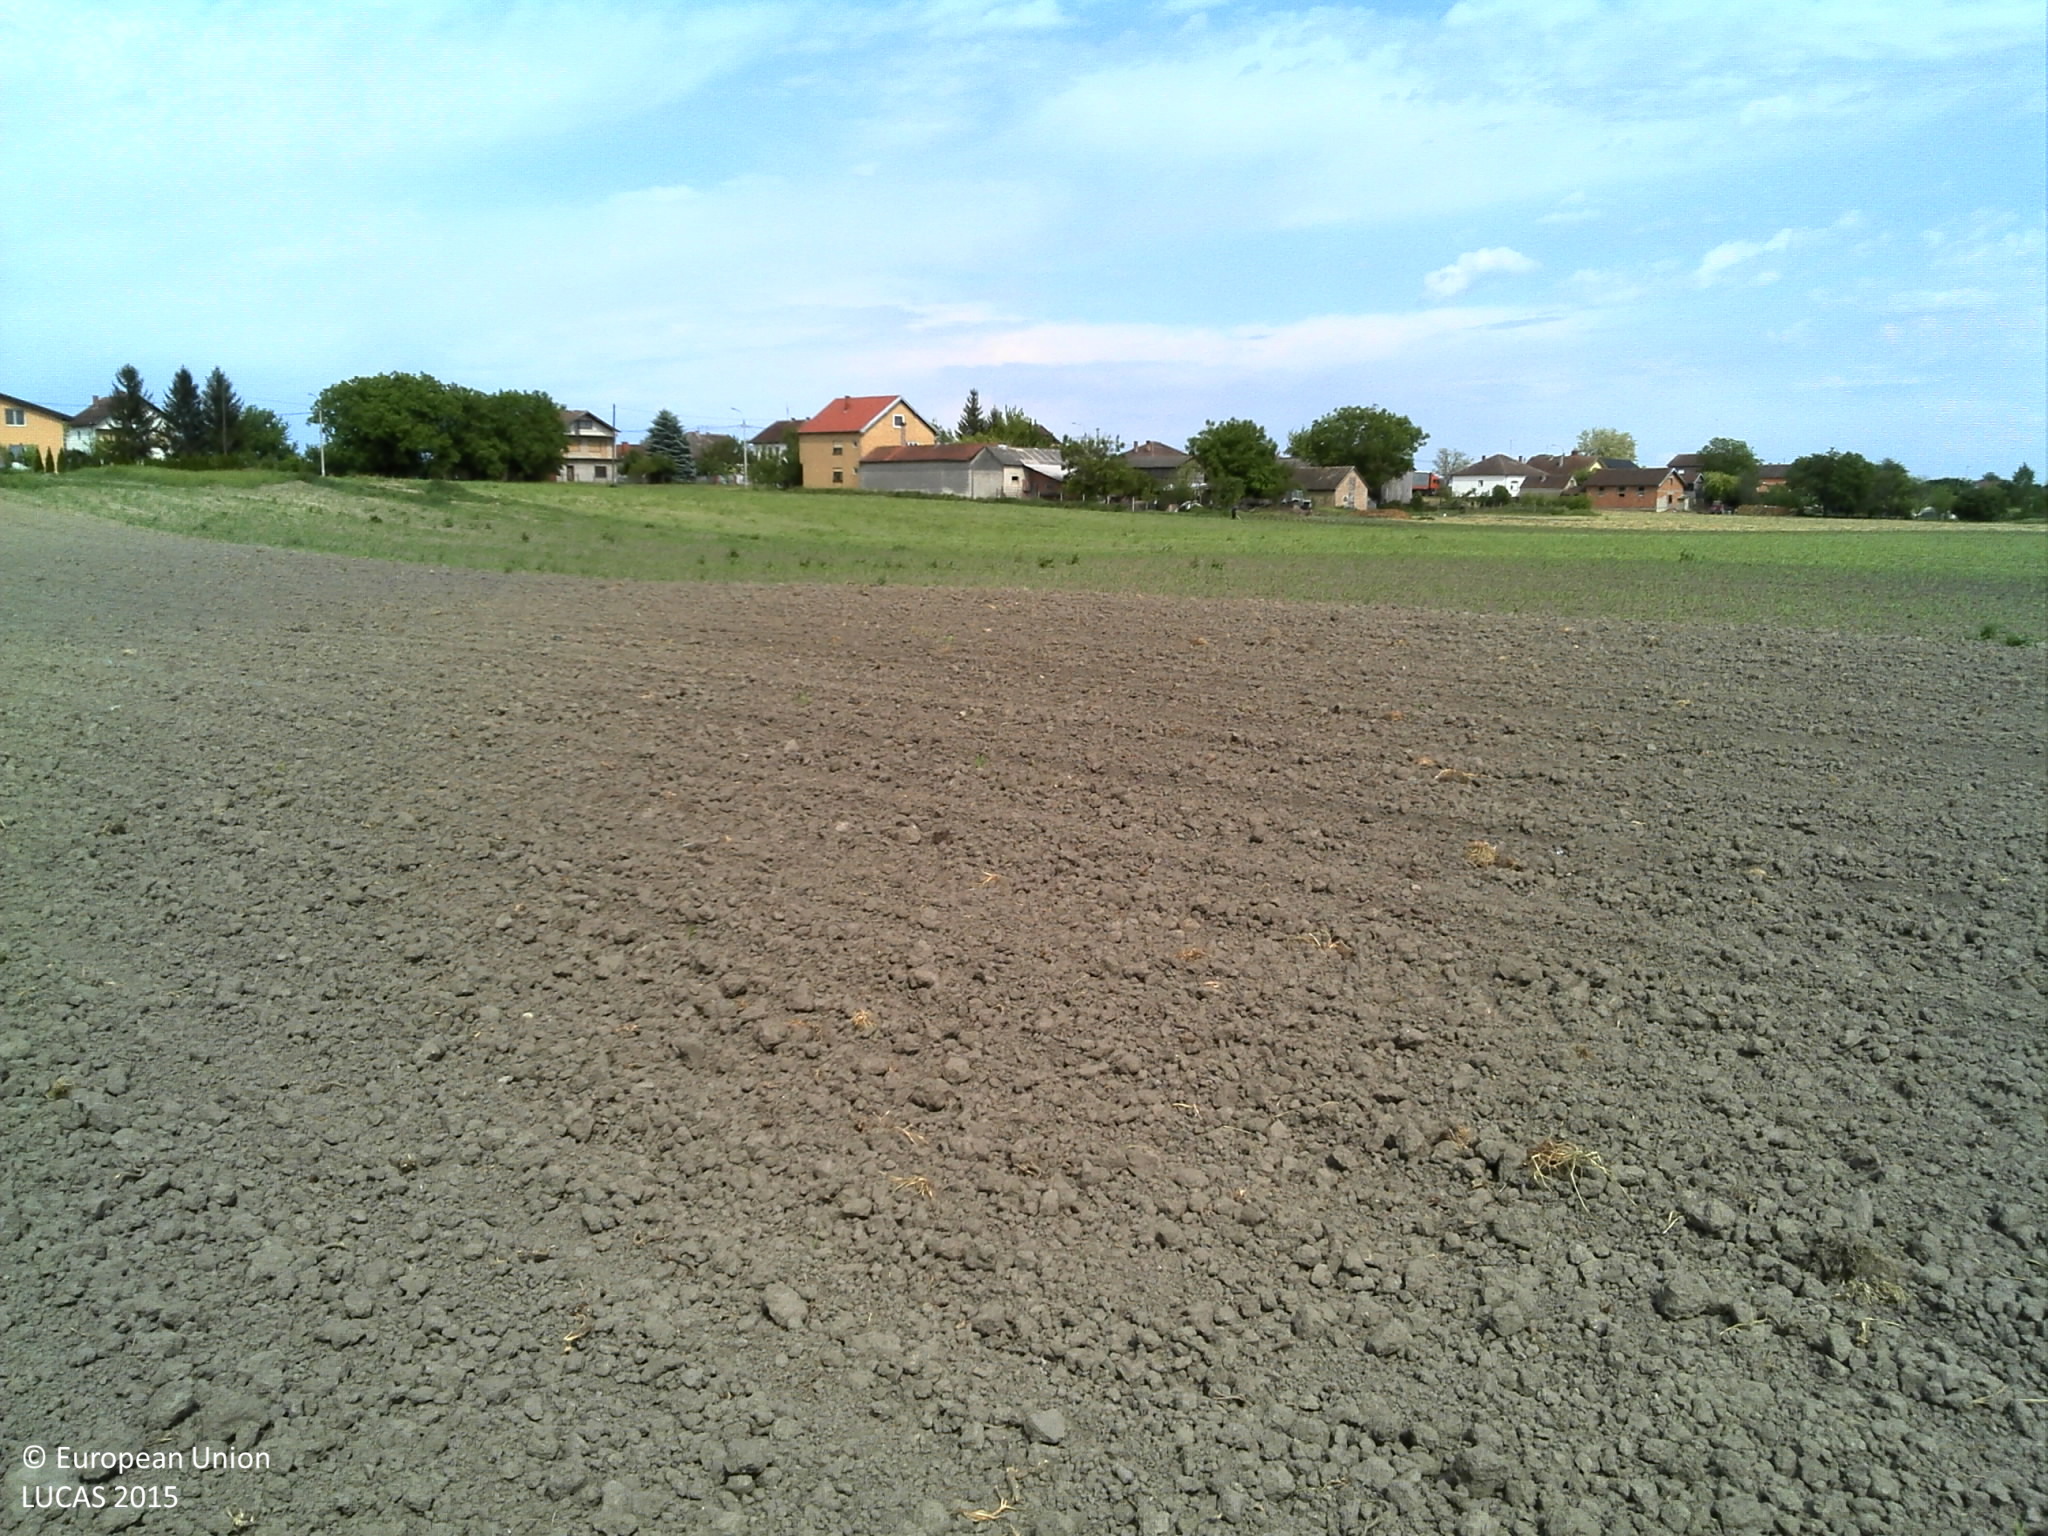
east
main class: Cropland
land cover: Barley
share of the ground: > 75 %
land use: Agriculture (excluding fallow land and kitchen gardens)
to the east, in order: Barley; Maize; Sunflower; Maize; Dry pulses; Potatoes; Grass margins; Artificial constructions in urban areas
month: May
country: HR
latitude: 45.6545
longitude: 18.6702
